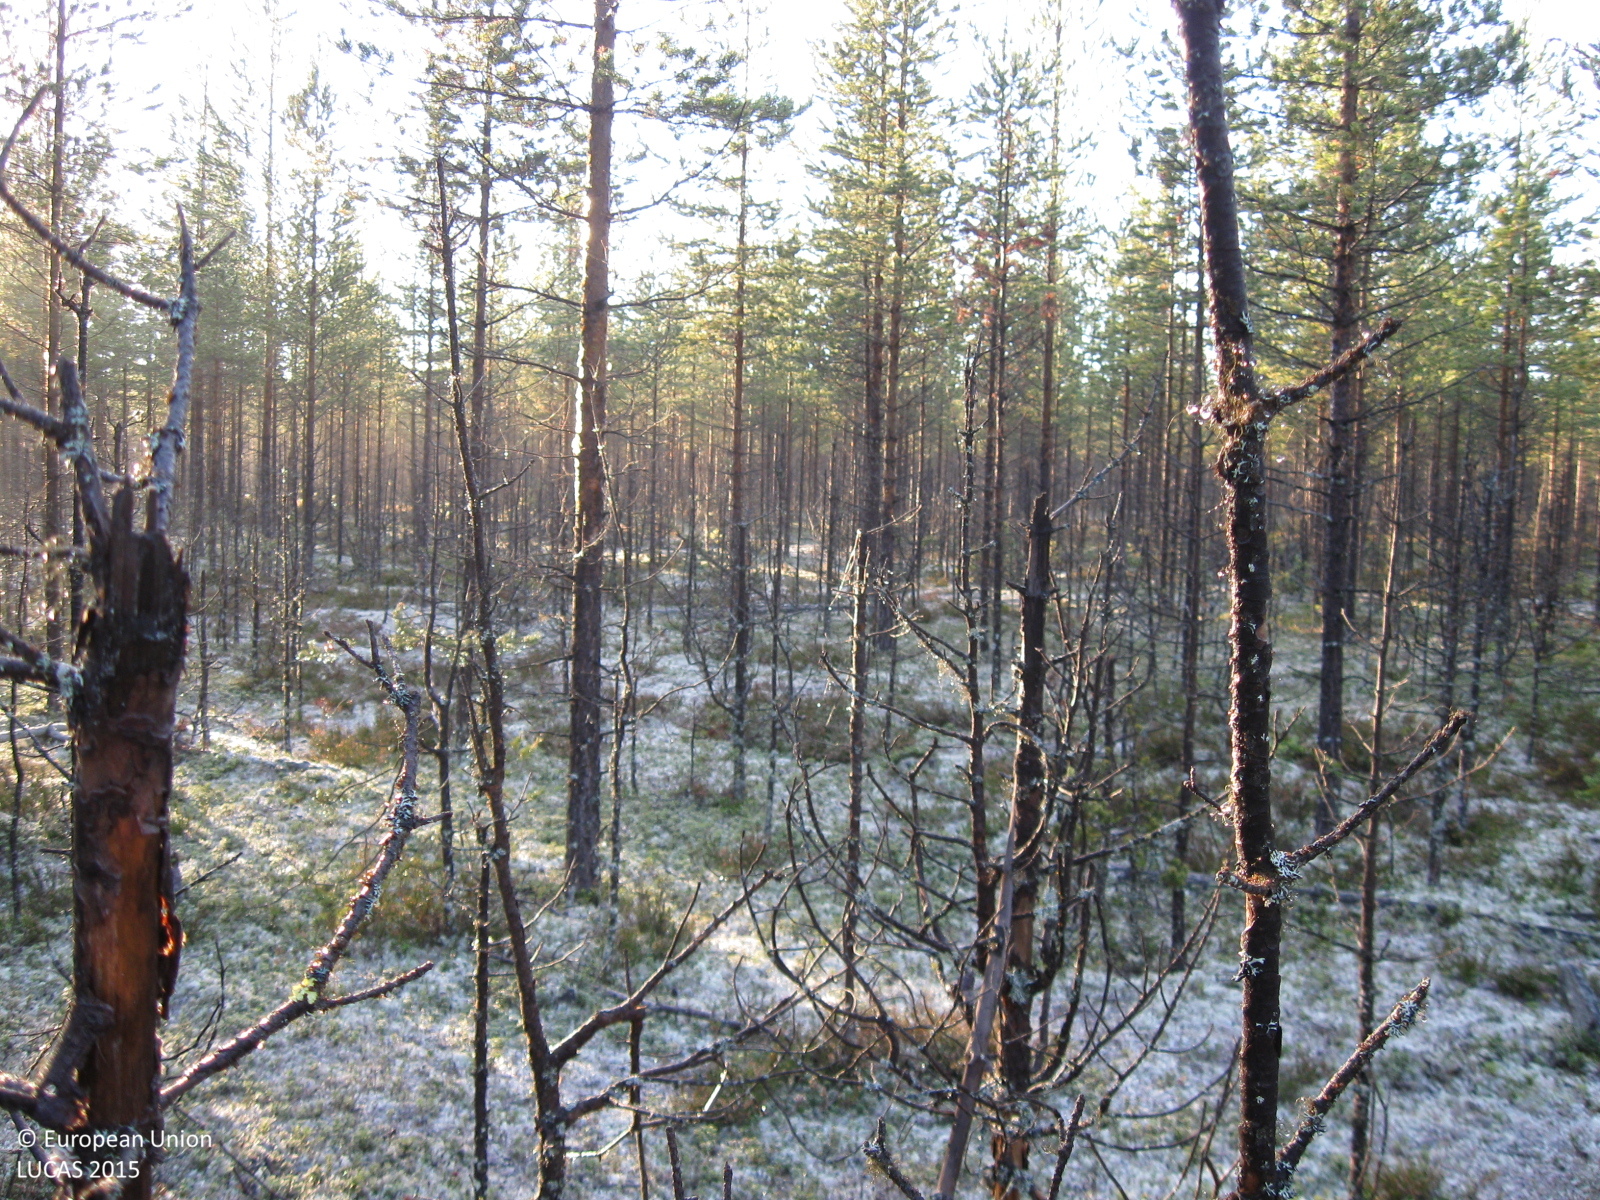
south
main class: Woodland
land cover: Pine dominated coniferous woodland
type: boreal forest
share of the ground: 50 - 75 %
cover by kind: coniferous forest trees 55 %, lichens and mosses 30 %, shrubs 10 %, herbaceous plants 5 %
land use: Forestry
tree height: > 5 m
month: October
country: SE
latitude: 66.2738
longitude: 20.8518
